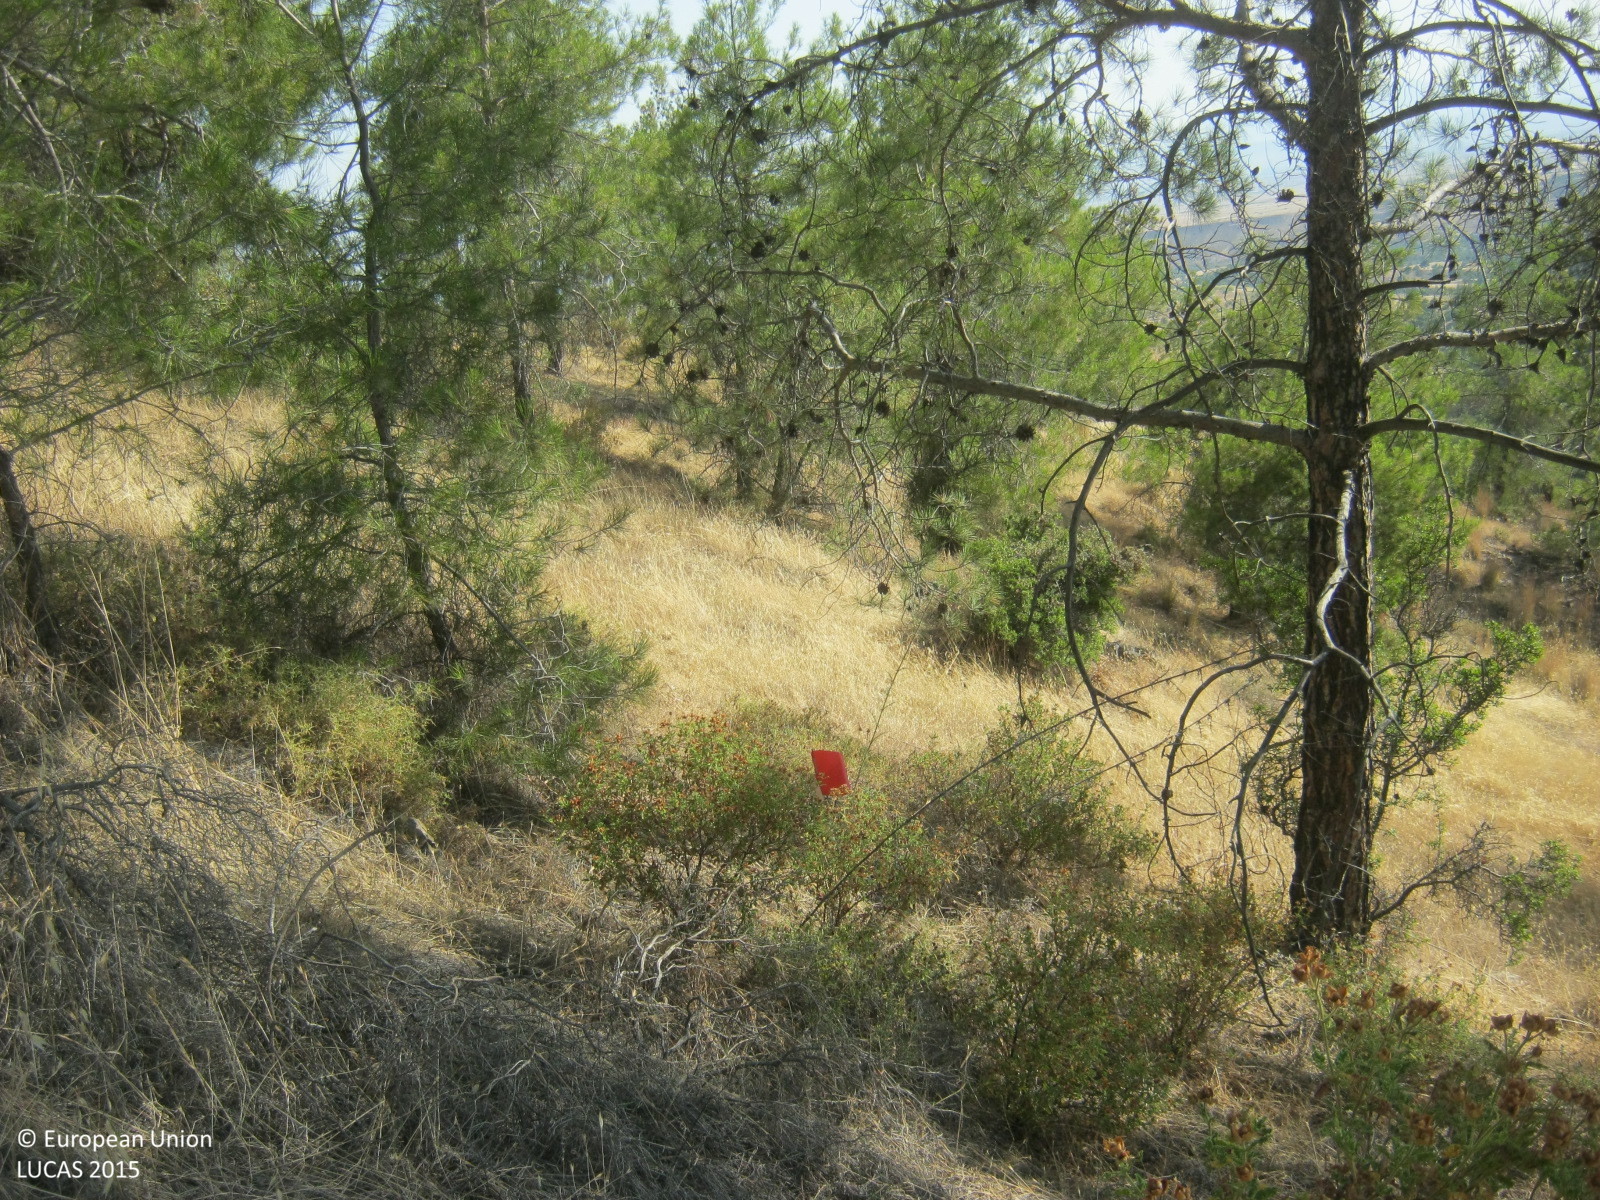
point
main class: Woodland
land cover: Pine dominated coniferous woodland
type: coniferous forest of the mediterranean region
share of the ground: > 75 %
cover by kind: coniferous forest trees 75 %, herbaceous plants 15 %, shrubs 10 %
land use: Forestry
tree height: > 5 m
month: June
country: CY
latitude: 35.0583
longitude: 32.9928
